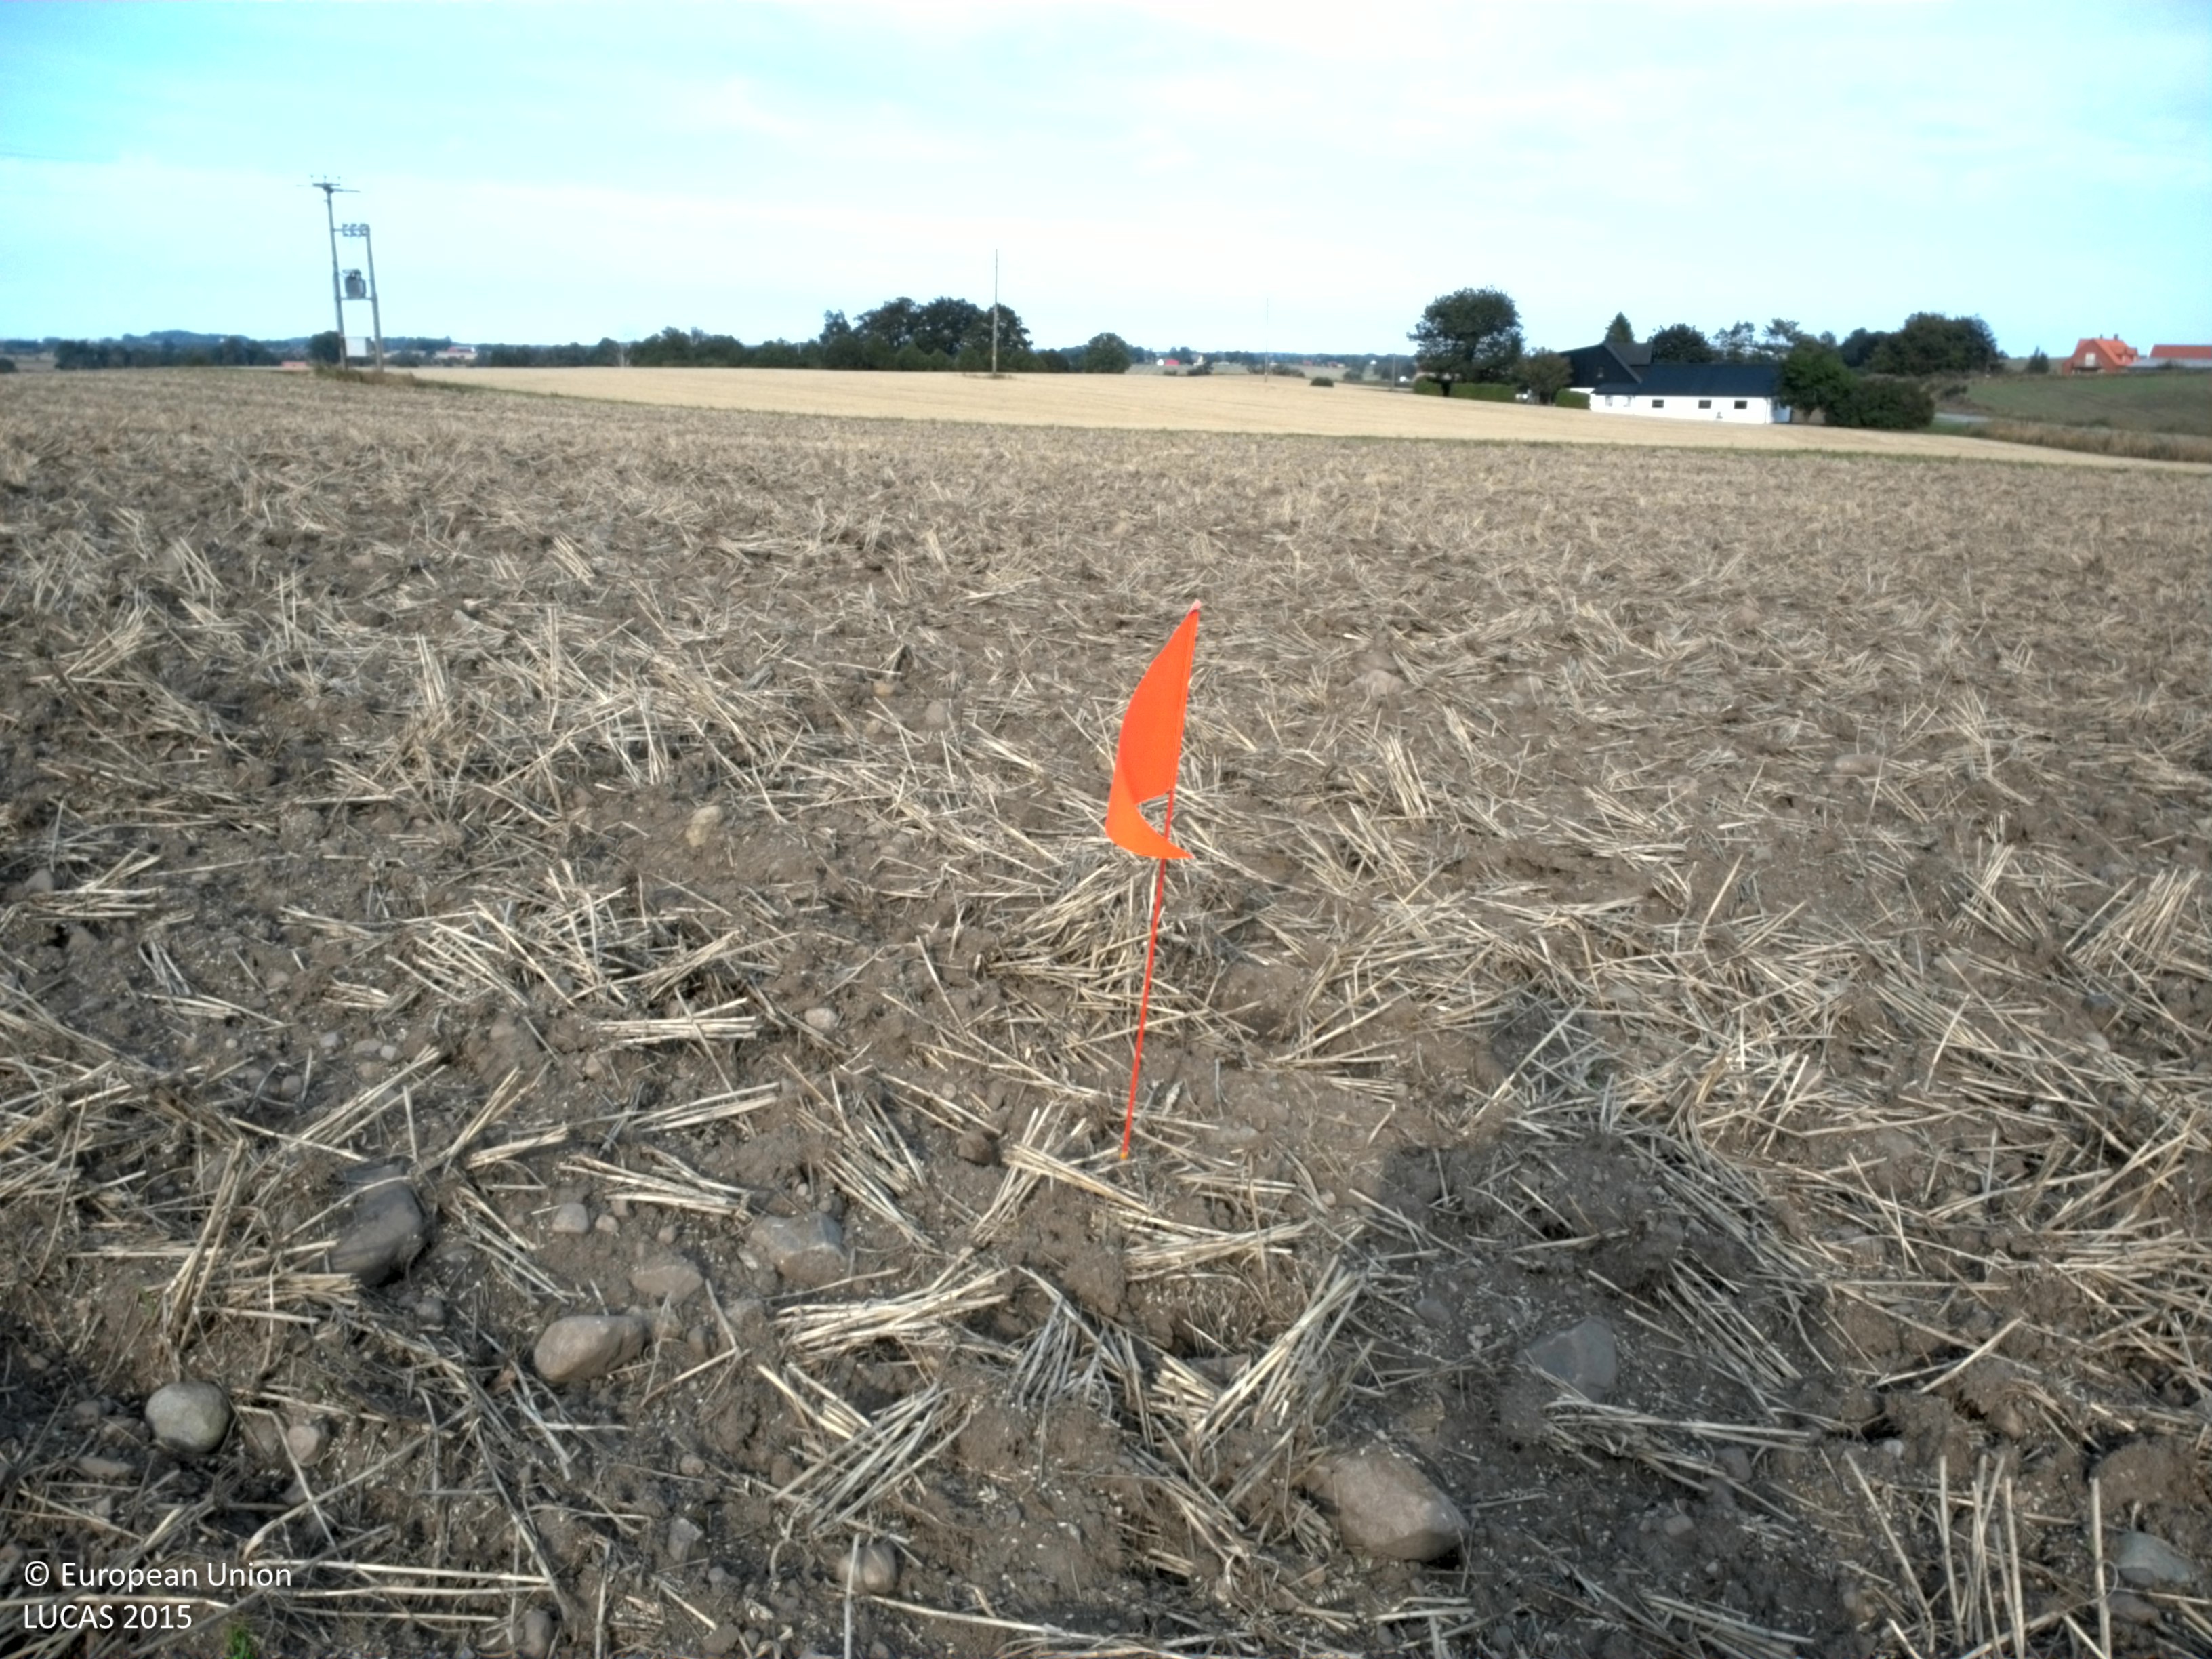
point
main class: Cropland
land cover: Common wheat
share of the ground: < 10 %
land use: Agriculture (excluding fallow land and kitchen gardens)
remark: Harvested field
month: September
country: SE
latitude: 55.5682
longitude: 13.9788
